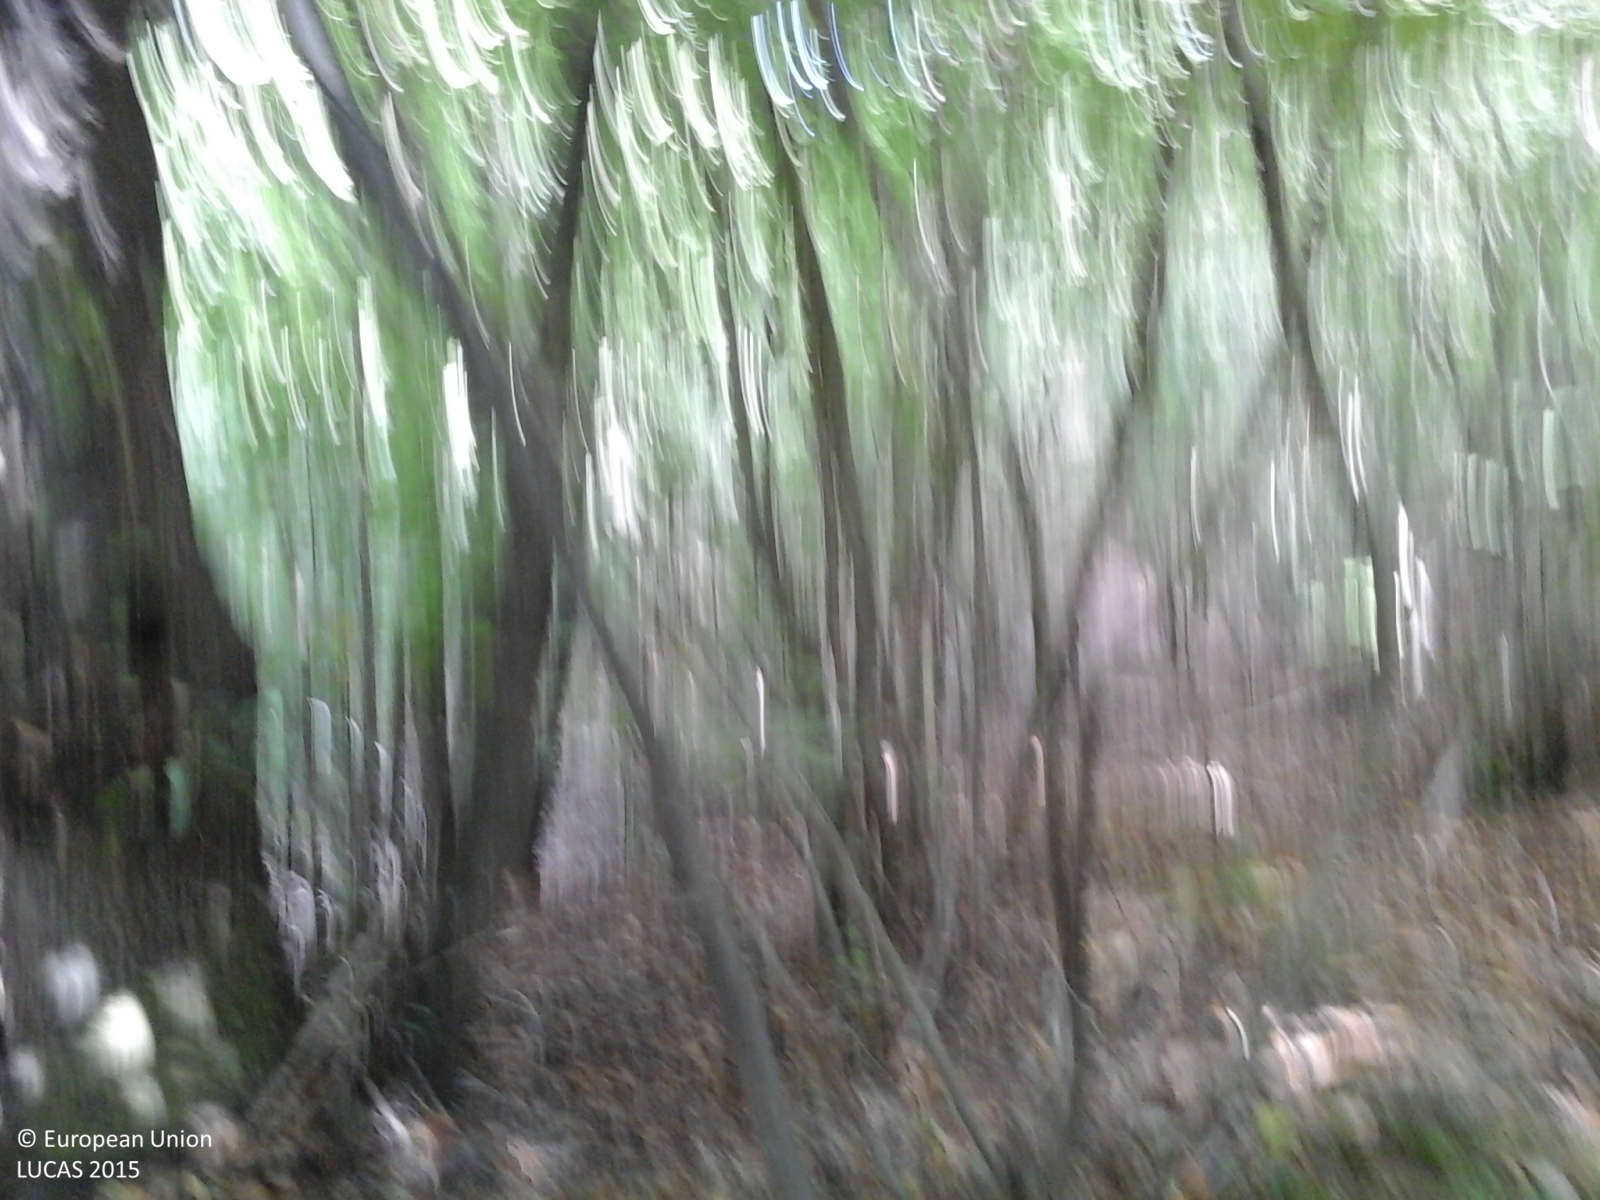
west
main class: Cropland
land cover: Nuts trees
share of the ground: > 75 %
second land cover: Spontaneously vegetated surfaces
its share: > 75 %
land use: Agriculture (excluding fallow land and kitchen gardens)
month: September
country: IT
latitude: 44.4830
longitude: 8.4317
